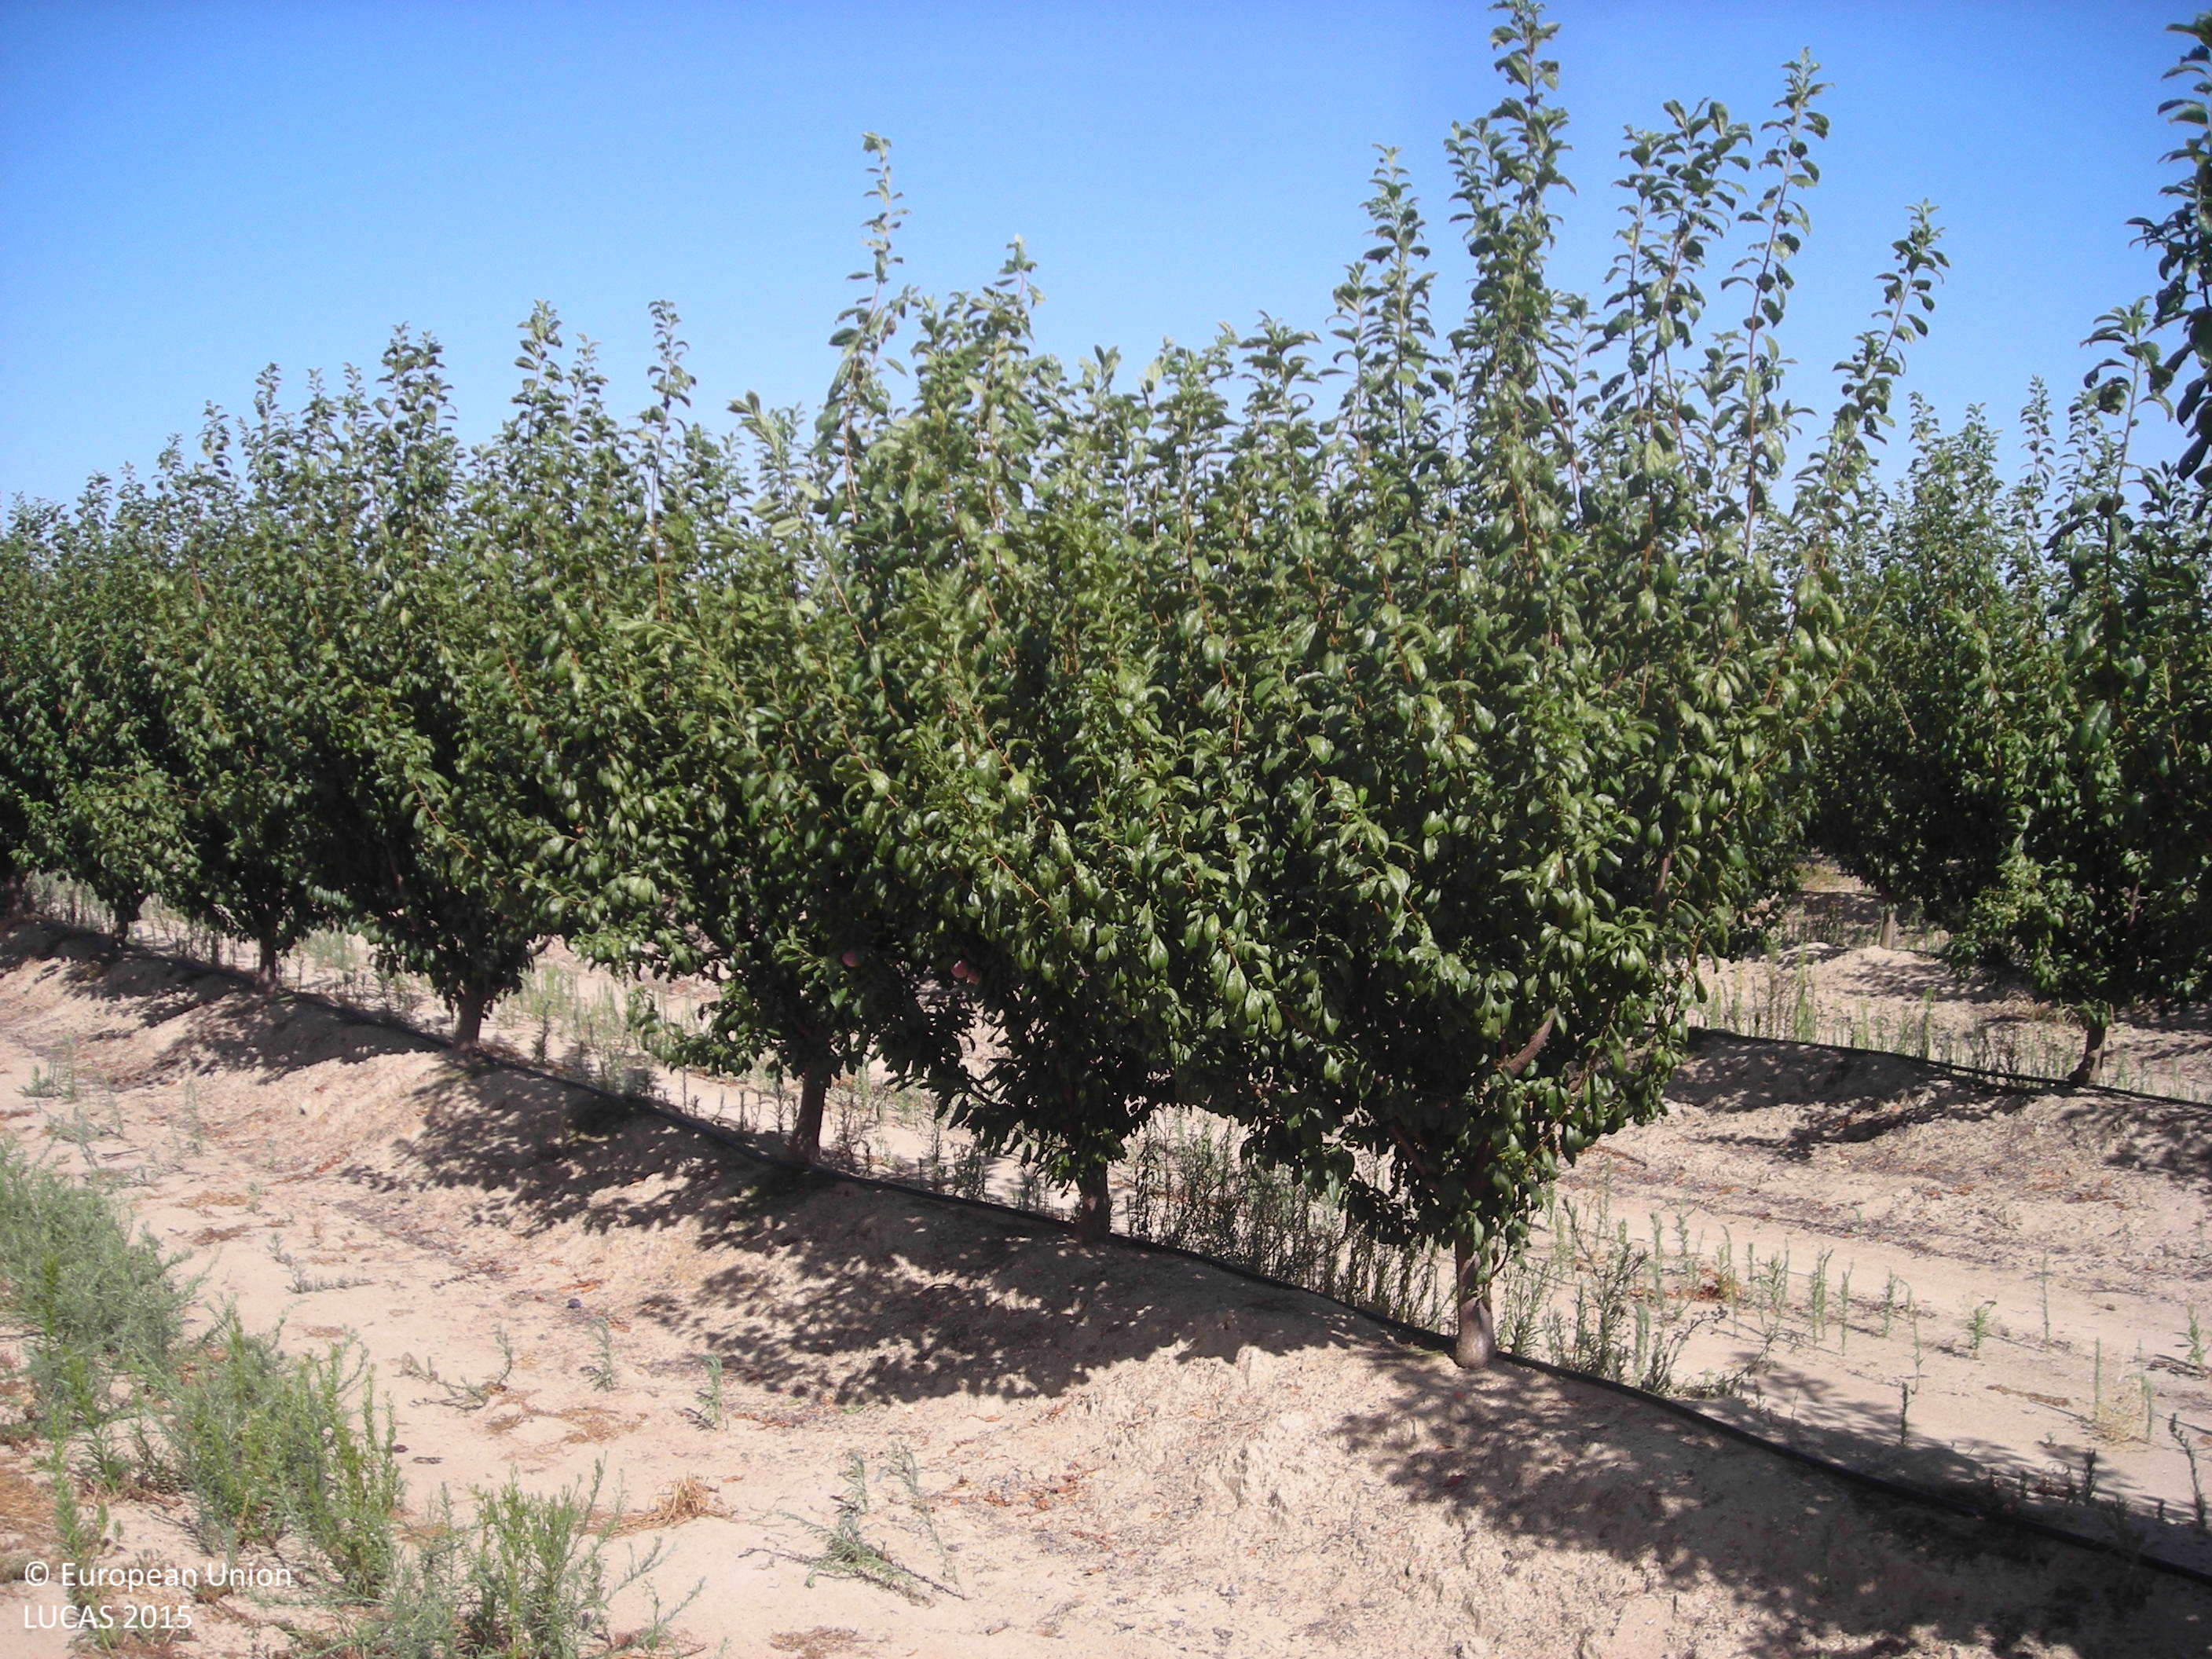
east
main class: Cropland
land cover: Maize
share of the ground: > 75 %
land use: Agriculture (excluding fallow land and kitchen gardens)
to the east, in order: Maize; Other fruit trees and berries; Tracks; Other bare soil; Tomatoes
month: July
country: ES
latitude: 38.9836
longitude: -5.8769
